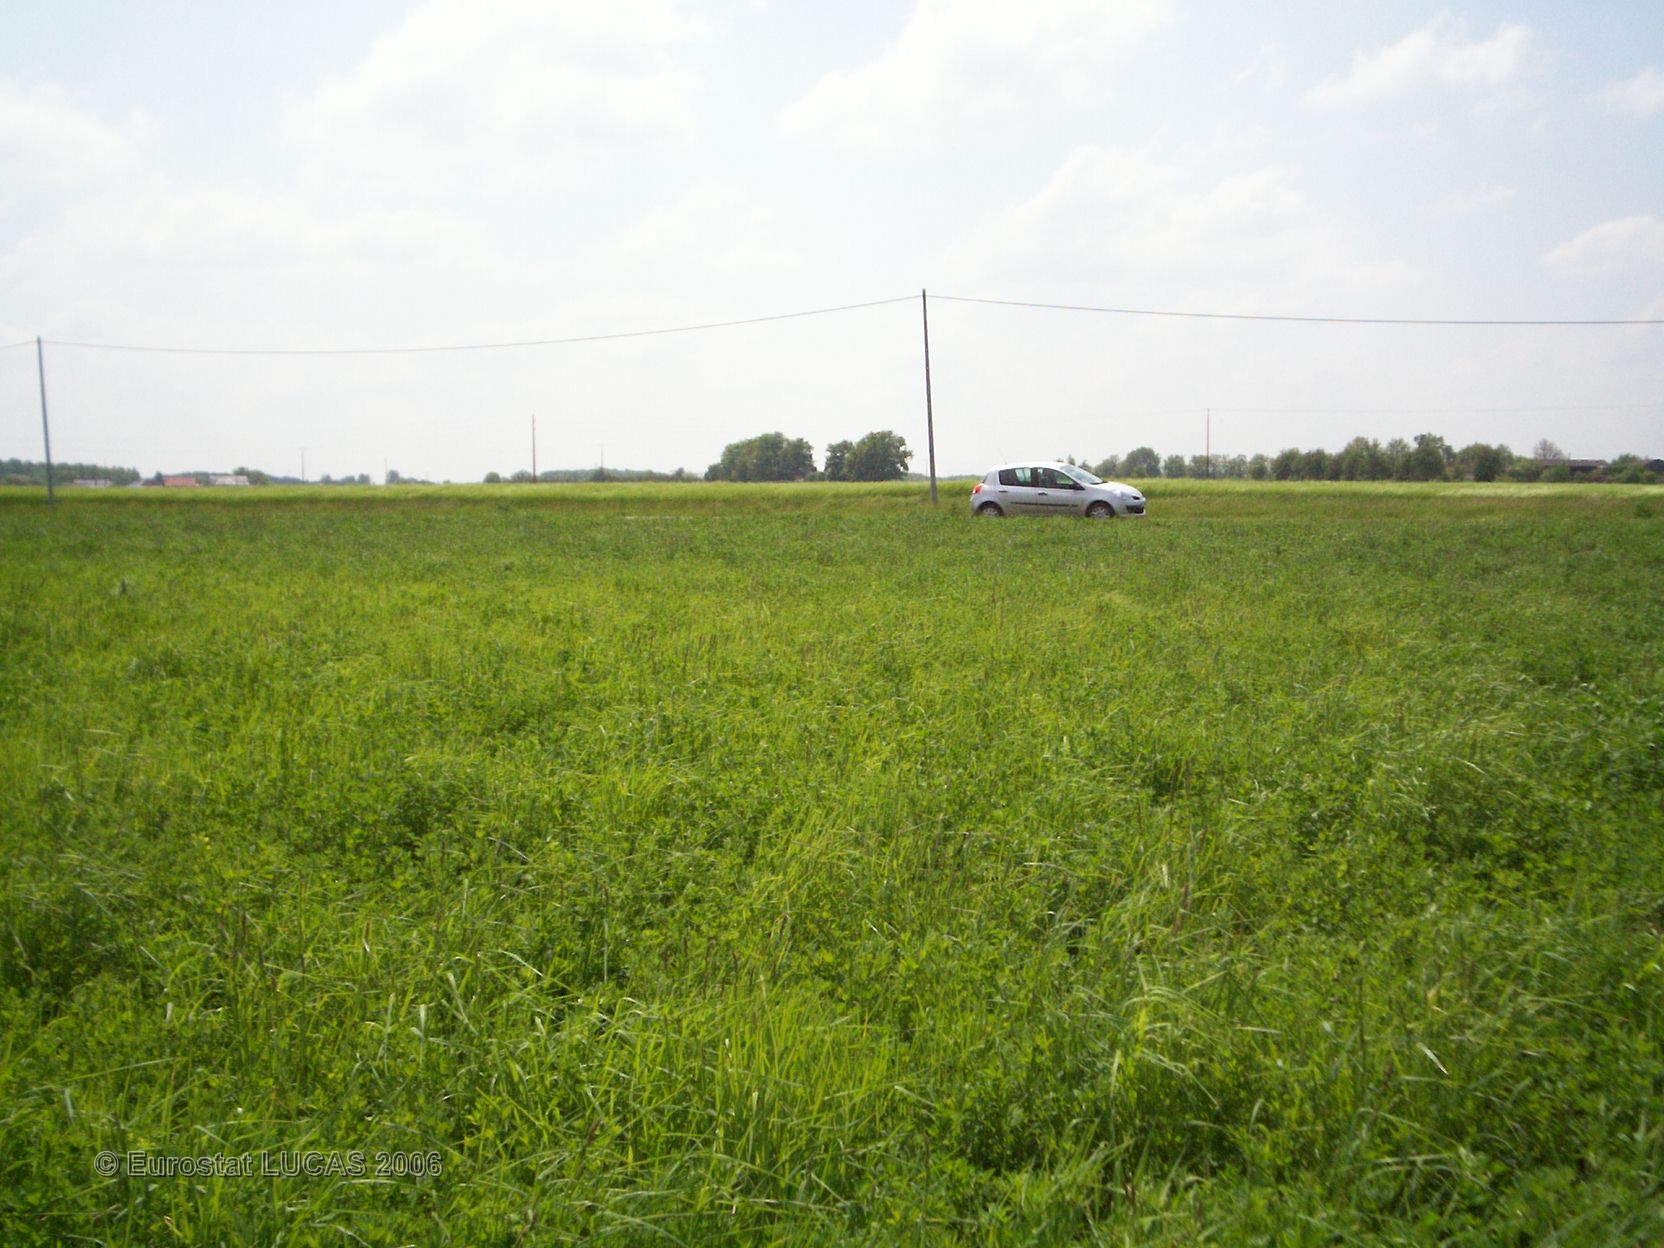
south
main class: Cropland
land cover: Lucerne
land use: Agriculture (excluding fallow land and kitchen gardens)
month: May
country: FR
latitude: 47.4822
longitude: 0.2490
